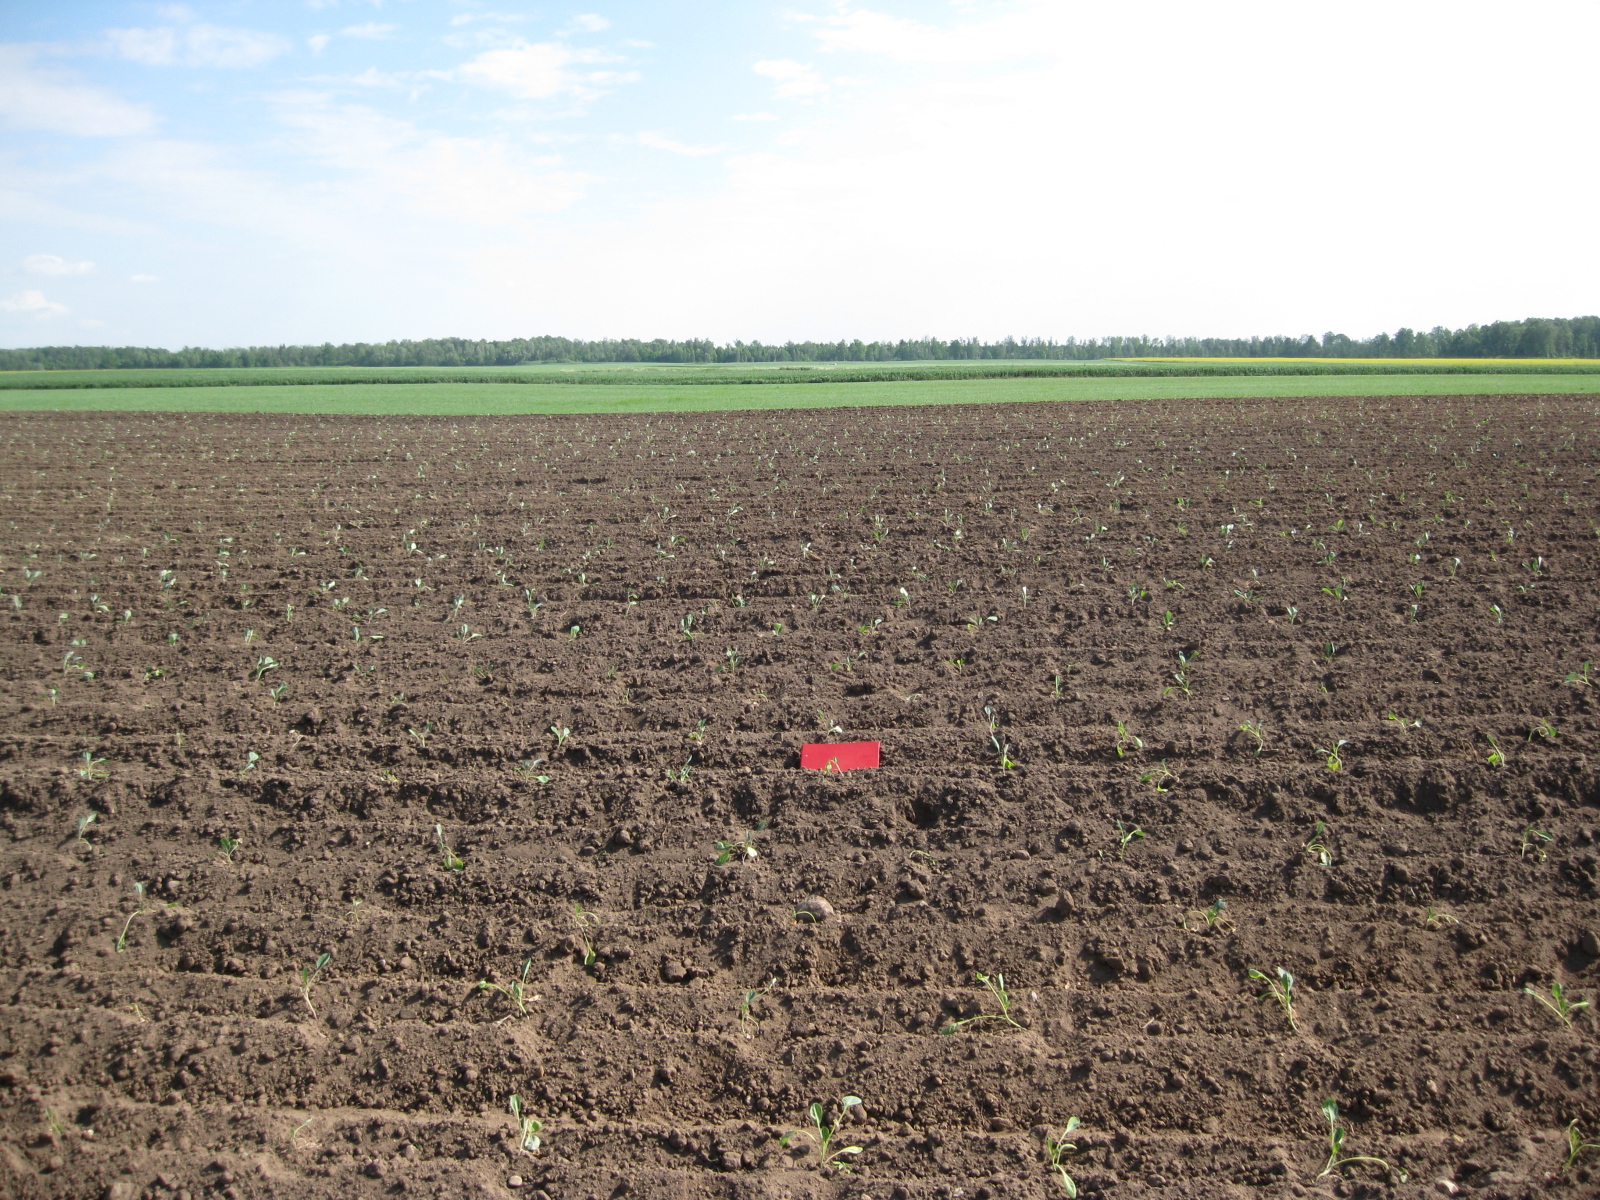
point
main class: Cropland
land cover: Other fresh vegetables
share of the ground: < 10 %
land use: Agriculture (excluding fallow land and kitchen gardens)
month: June
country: LT
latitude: 55.7829
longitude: 23.8132
